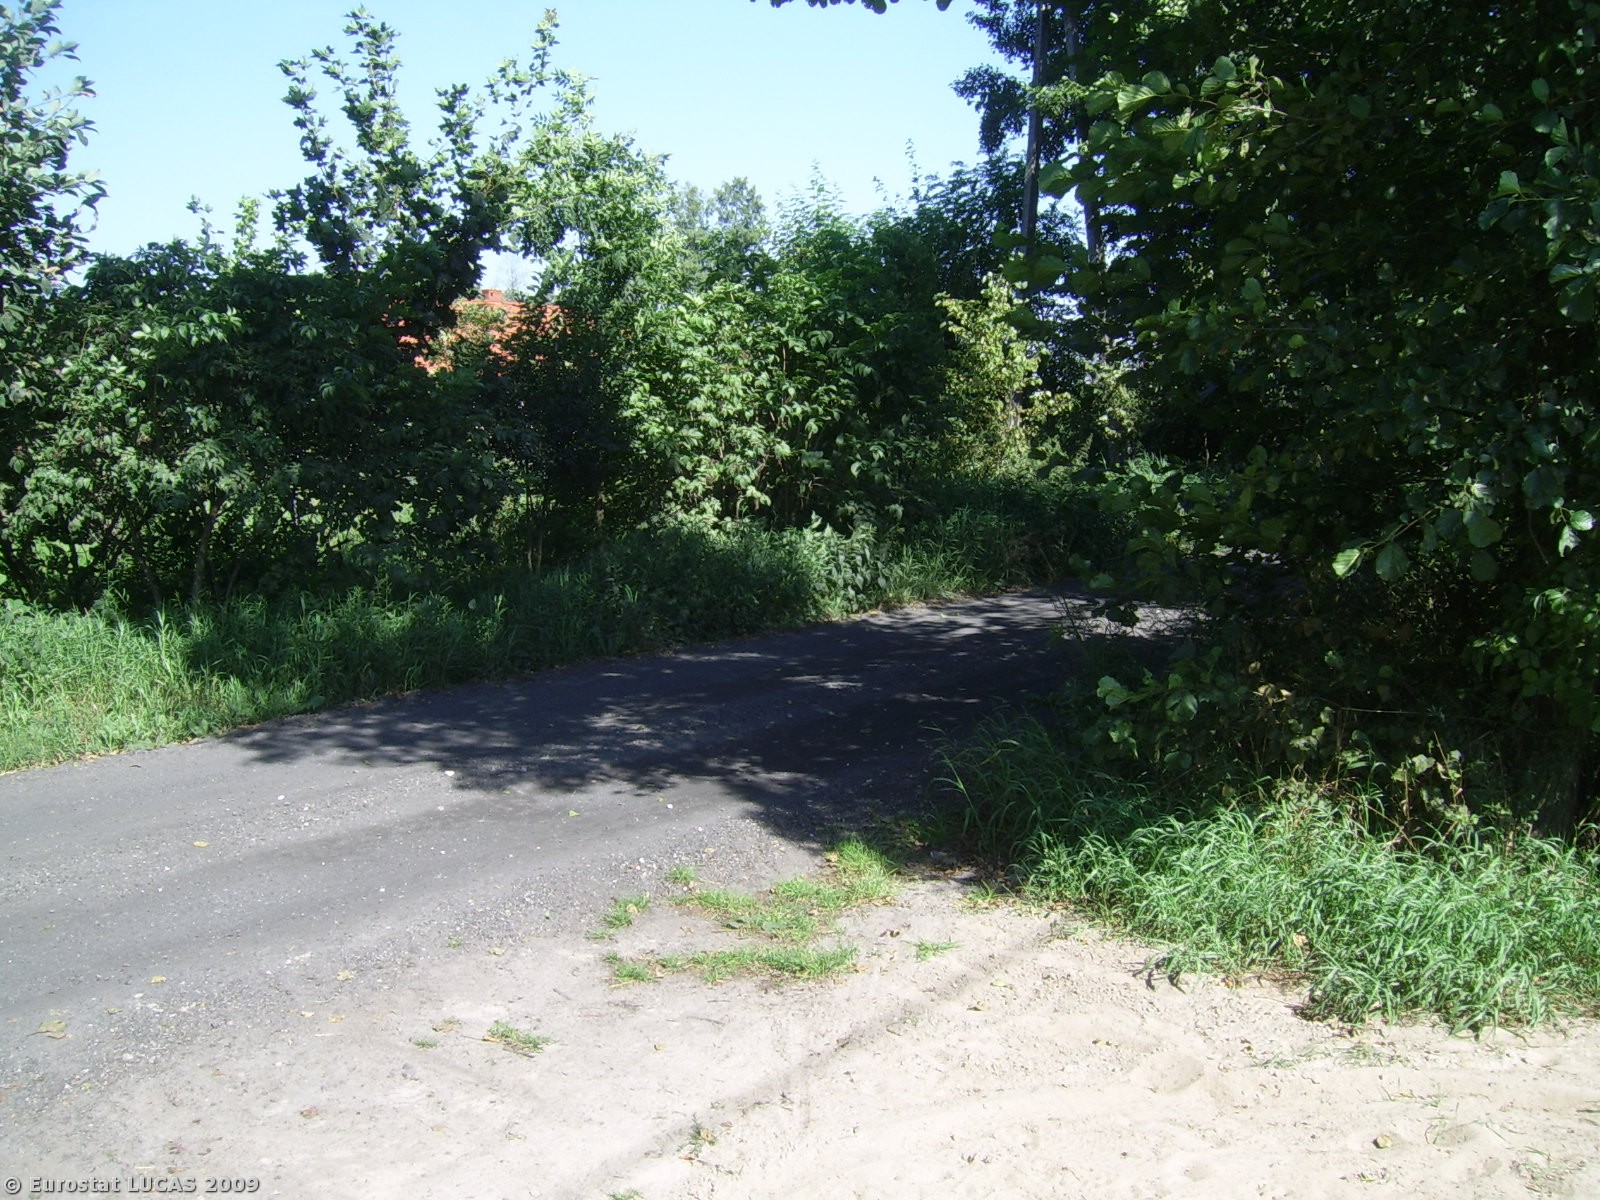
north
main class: Grassland
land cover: Grassland with sparse tree/shrub cover
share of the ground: > 75 %
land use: Residential
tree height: < 5 m
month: September
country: PL
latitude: 52.9775
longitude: 18.7328
